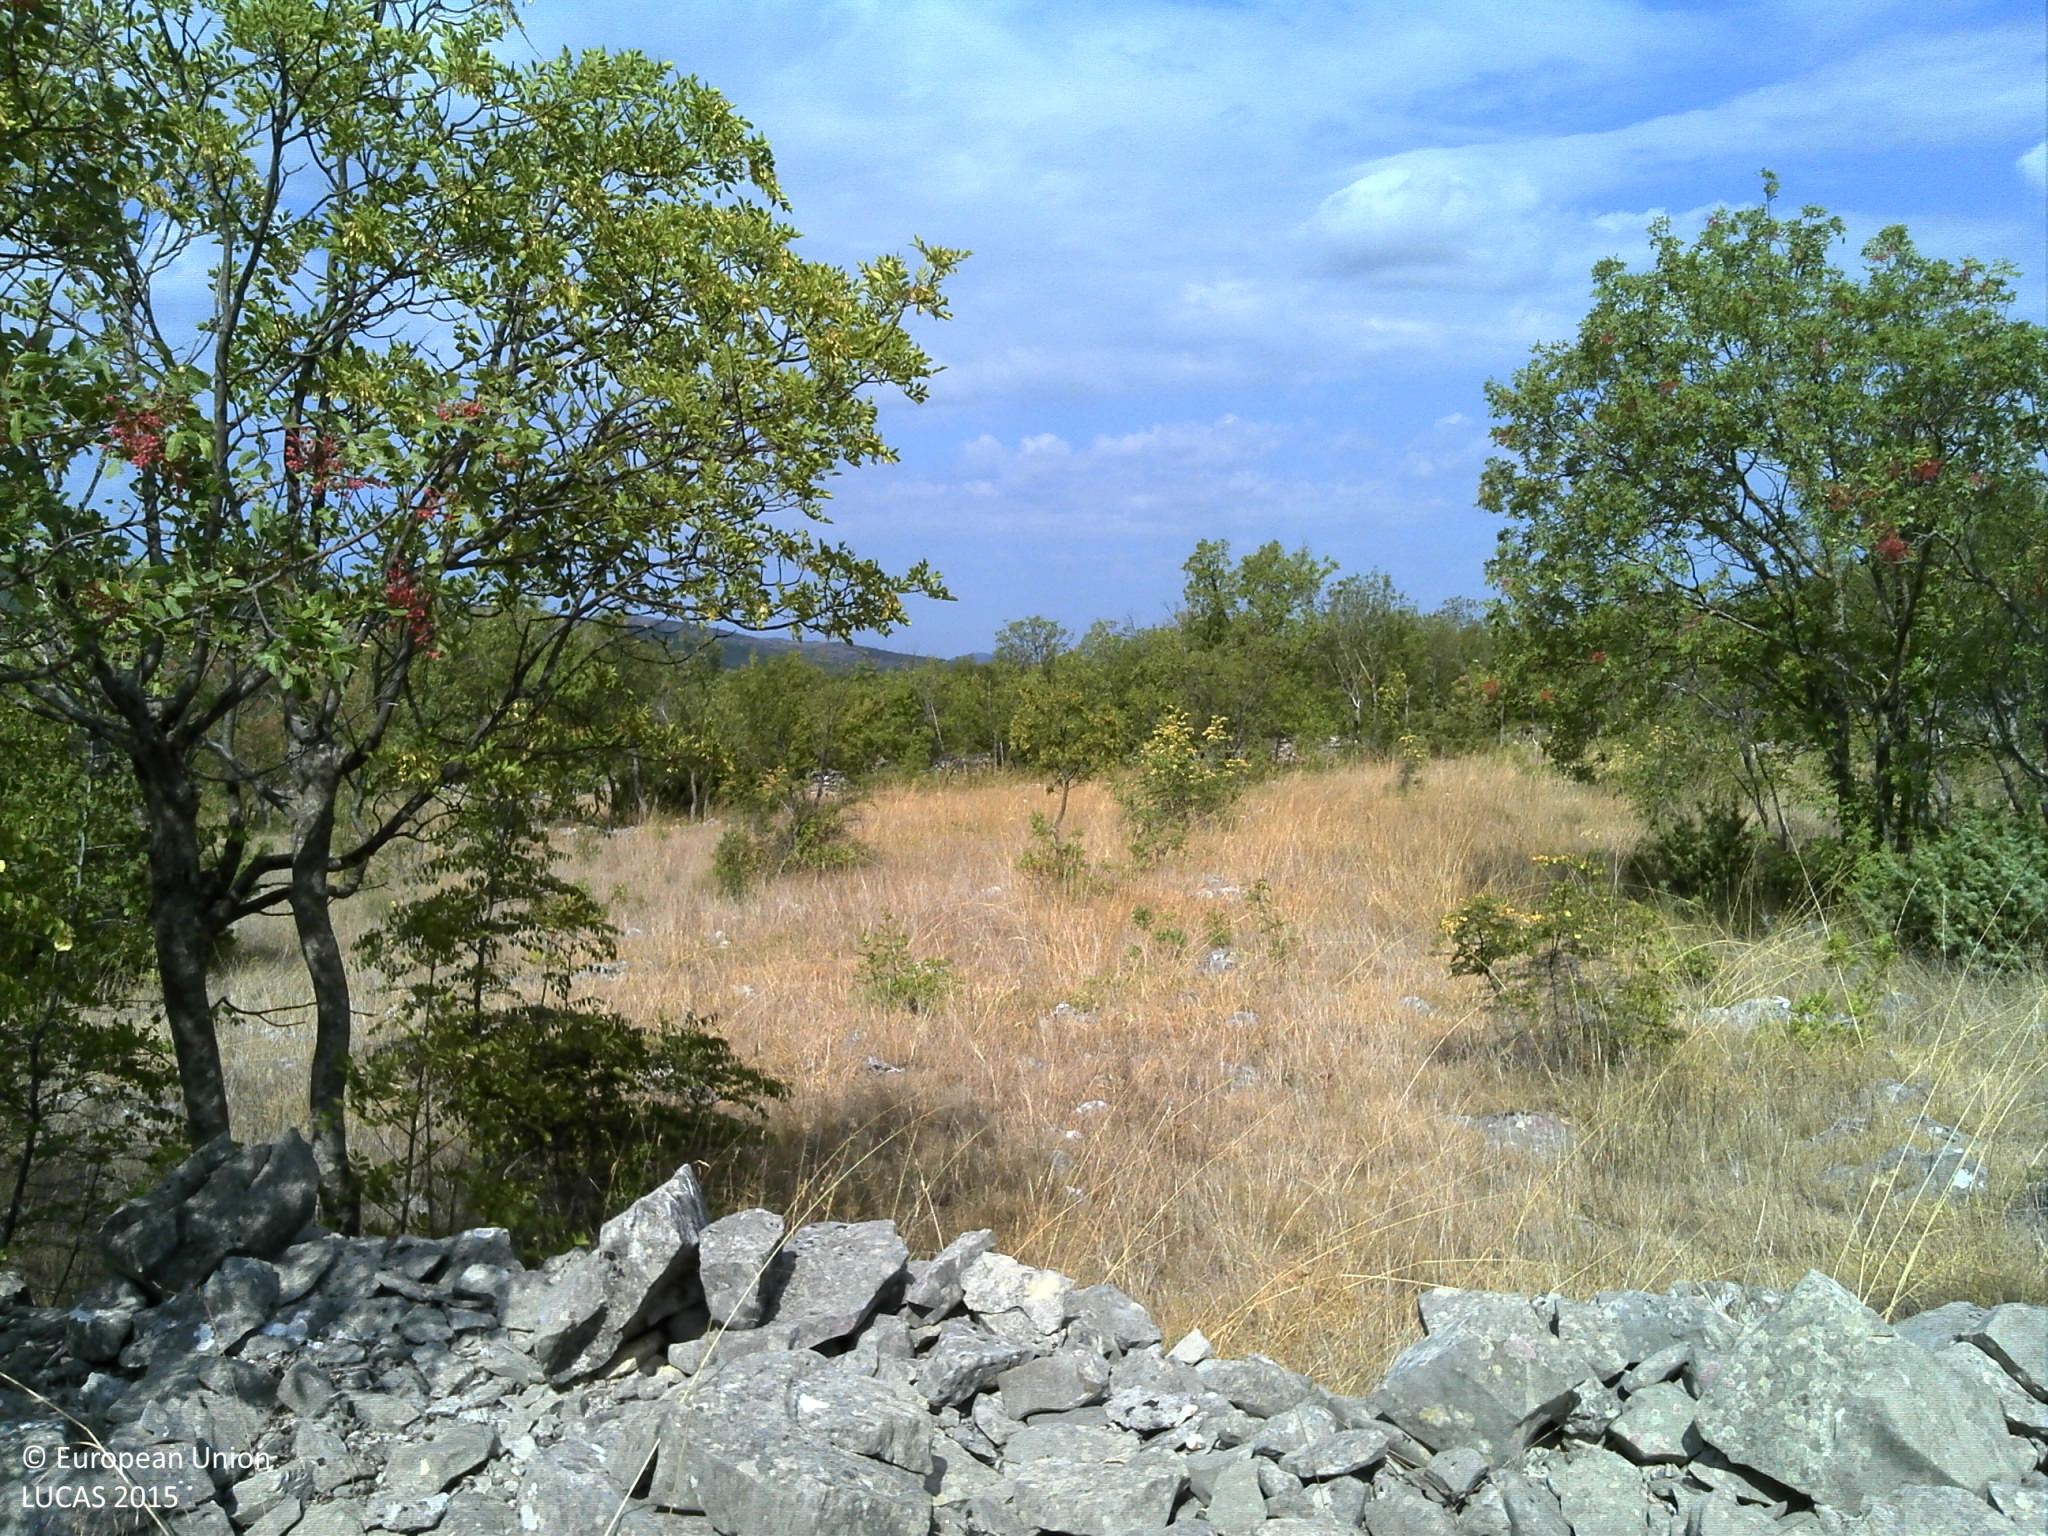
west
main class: Woodland
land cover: Broadleaved woodland
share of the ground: 10 - 25 %
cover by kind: herbaceous plants 70 %, broadleaved forest trees 15 %, shrubs 5 %, consolidated bare surface 5 %, unconsolidated bare surface 5 %
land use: Semi-natural and natural areas not in use
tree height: < 5 m
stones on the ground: < 10 %
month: July
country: HR
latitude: 43.7542
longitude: 16.1143
